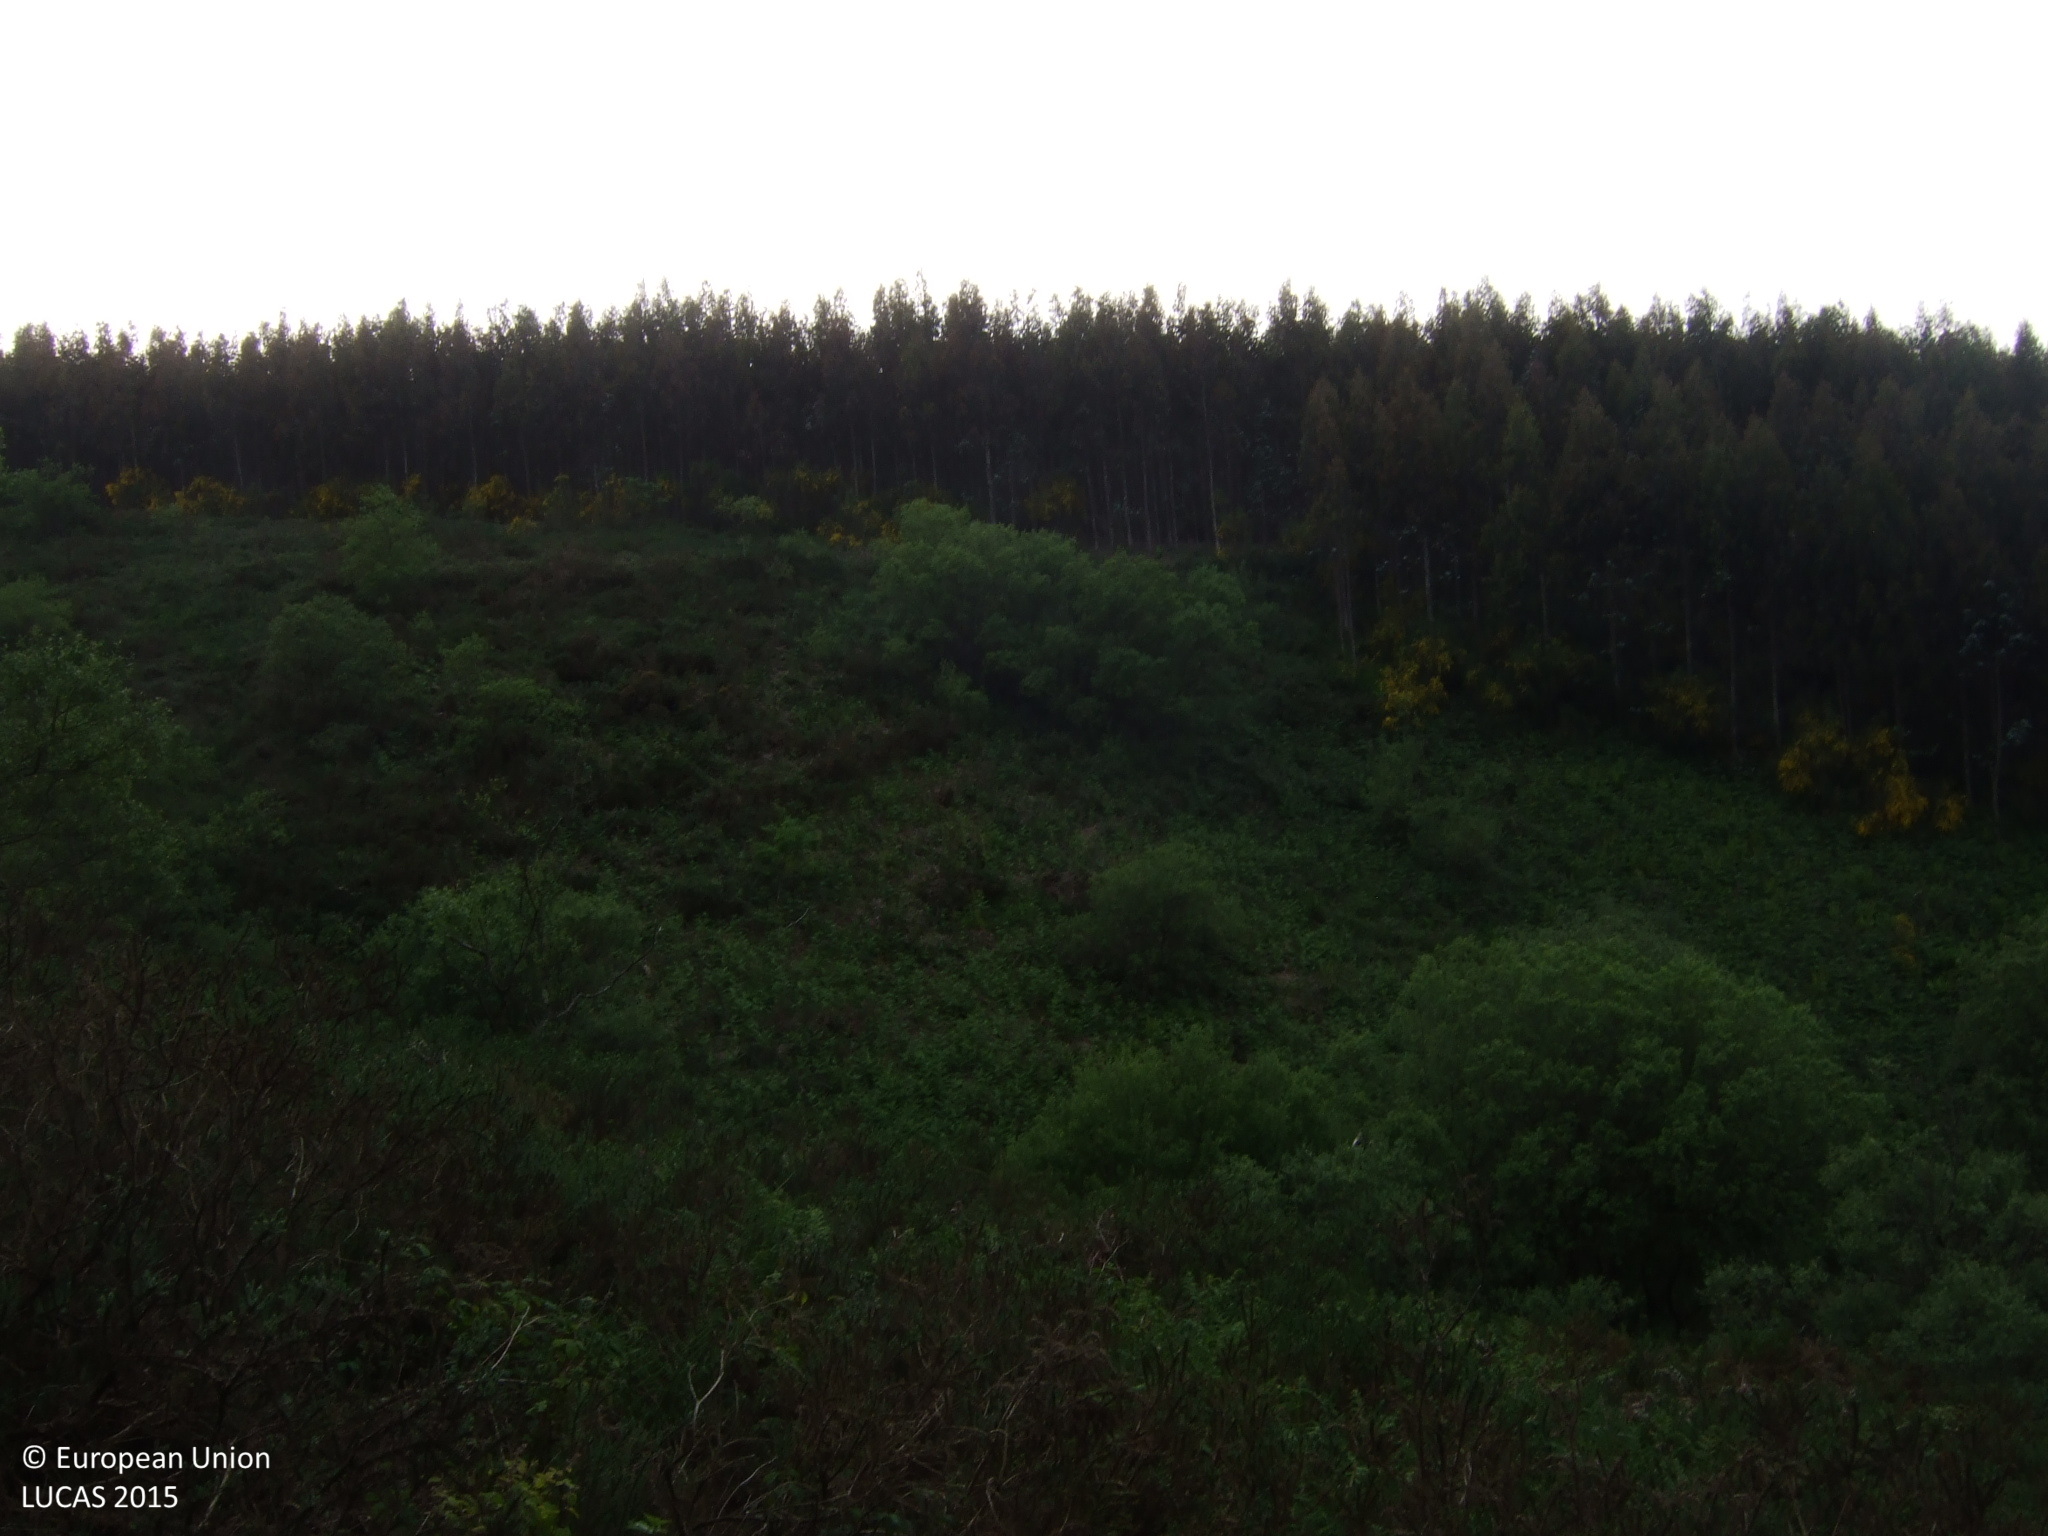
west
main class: Shrubland
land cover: Shrubland without tree cover
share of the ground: > 75 %
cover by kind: shrubs 90 %, herbaceous plants 10 %
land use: Semi-natural and natural areas not in use
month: June
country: ES
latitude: 43.3398
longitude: -7.4330
